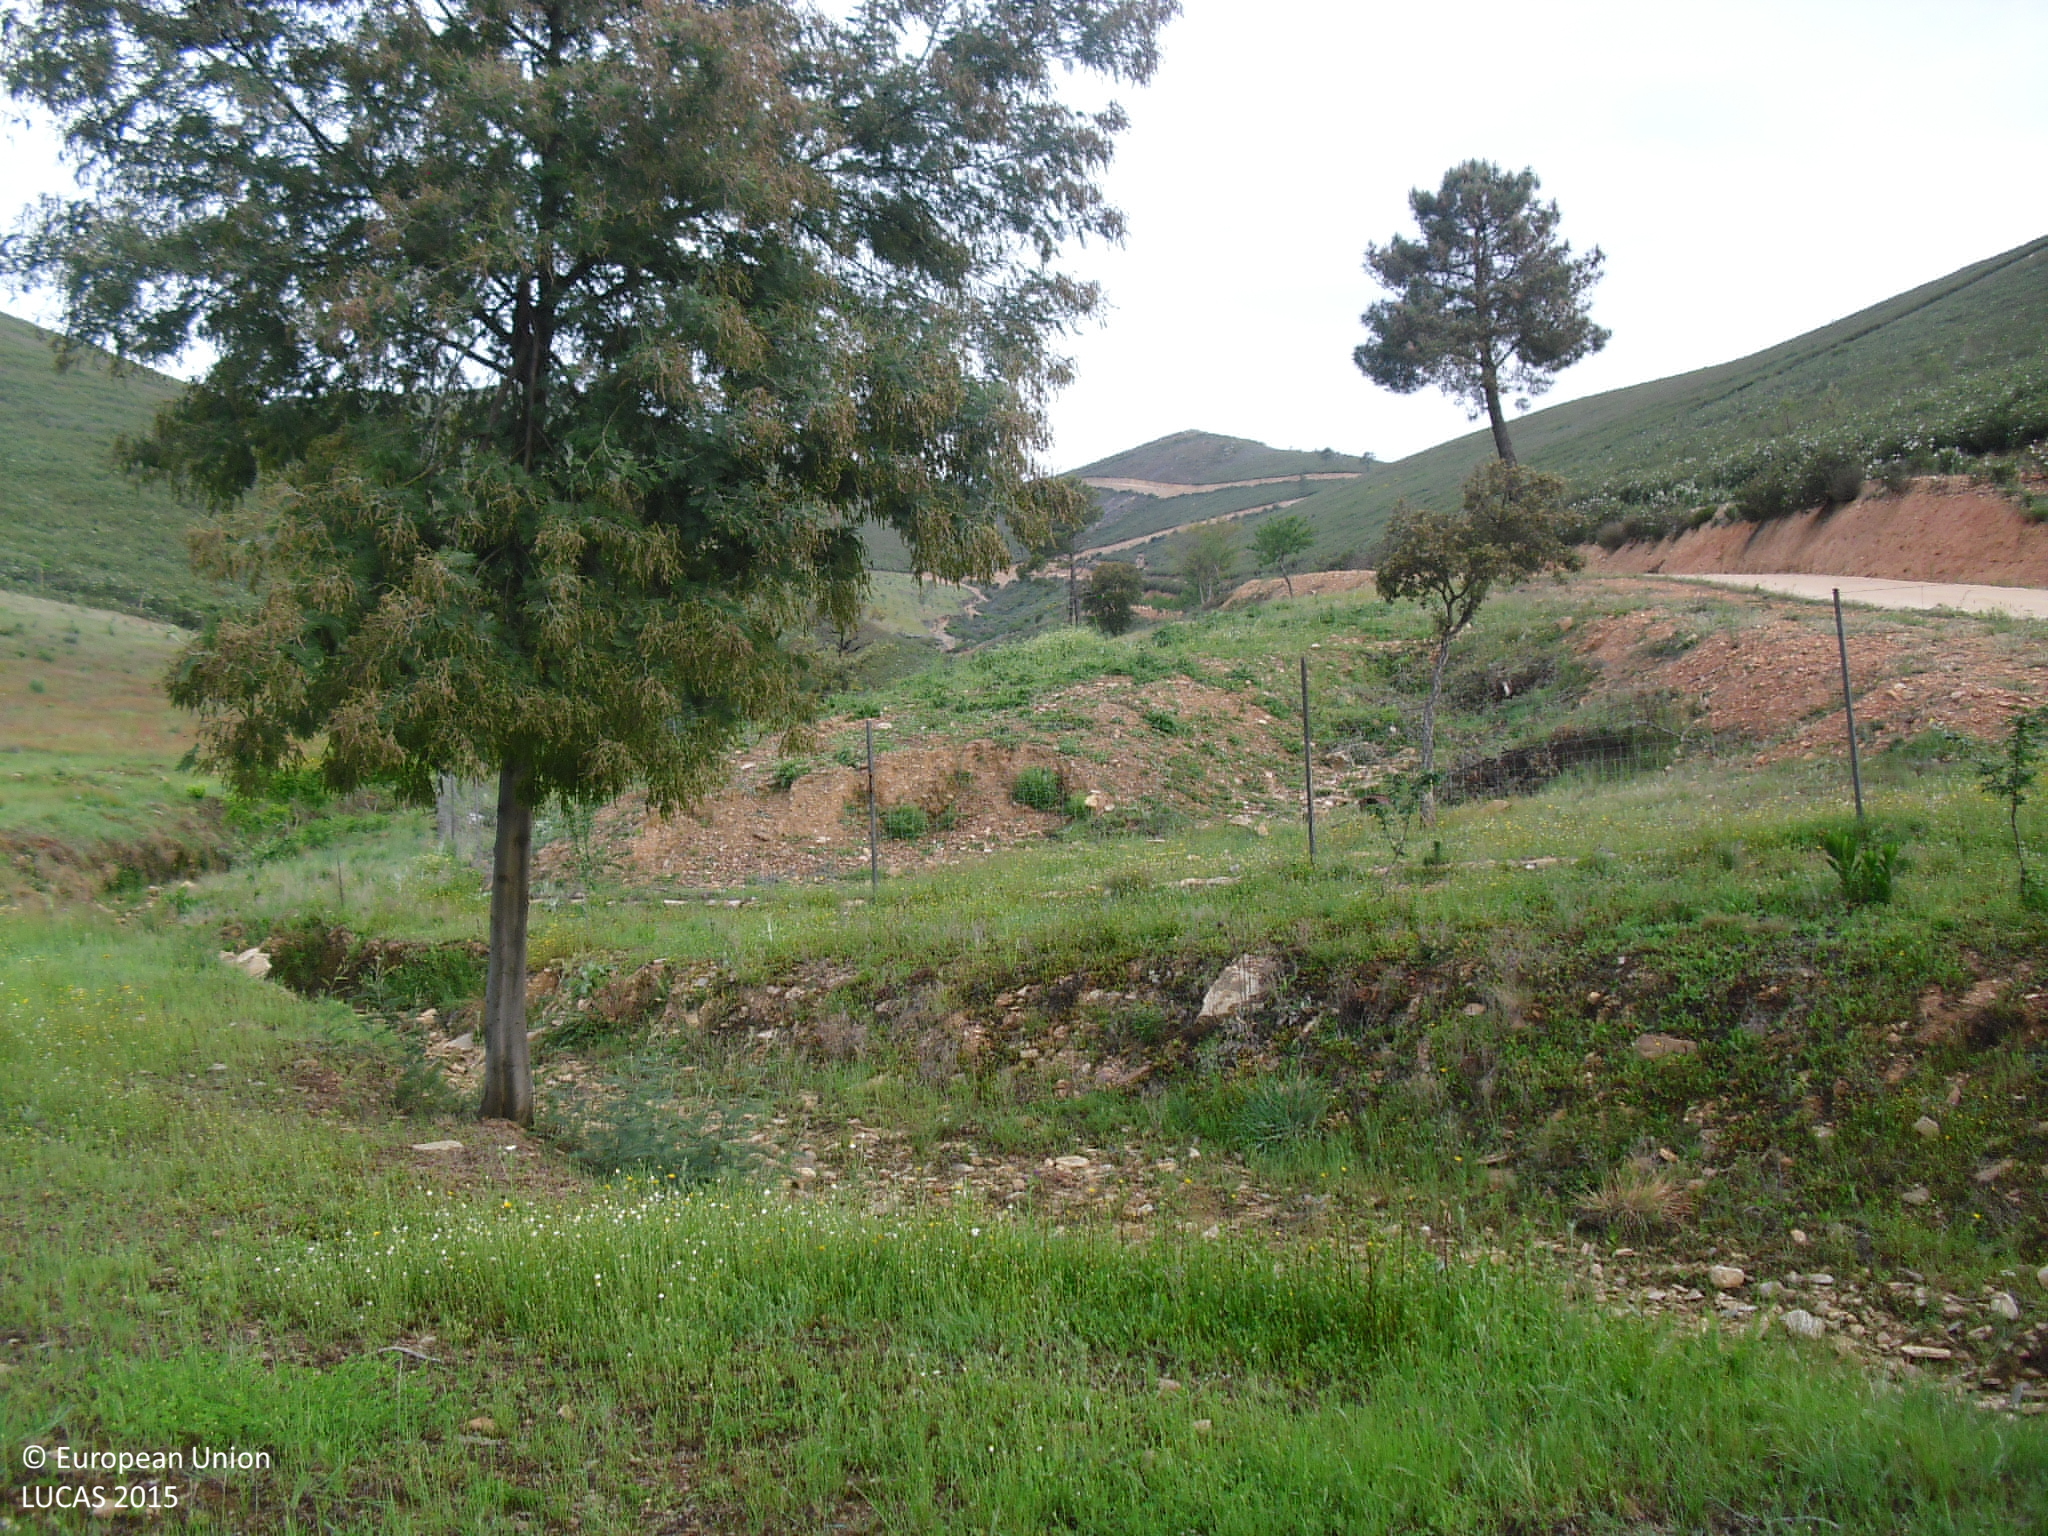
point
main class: Woodland
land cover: Broadleaved woodland
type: thermophilous deciduous forest
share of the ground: 10 - 25 %
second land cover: Grassland without tree/shrub cover
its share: > 75 %
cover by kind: herbaceous plants 80 %, broadleaved forest trees 15 %, shrubs 5 %
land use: Forestry
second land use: Agriculture (excluding fallow land and kitchen gardens)
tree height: > 5 m
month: May
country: ES
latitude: 39.4160
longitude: -5.3685
